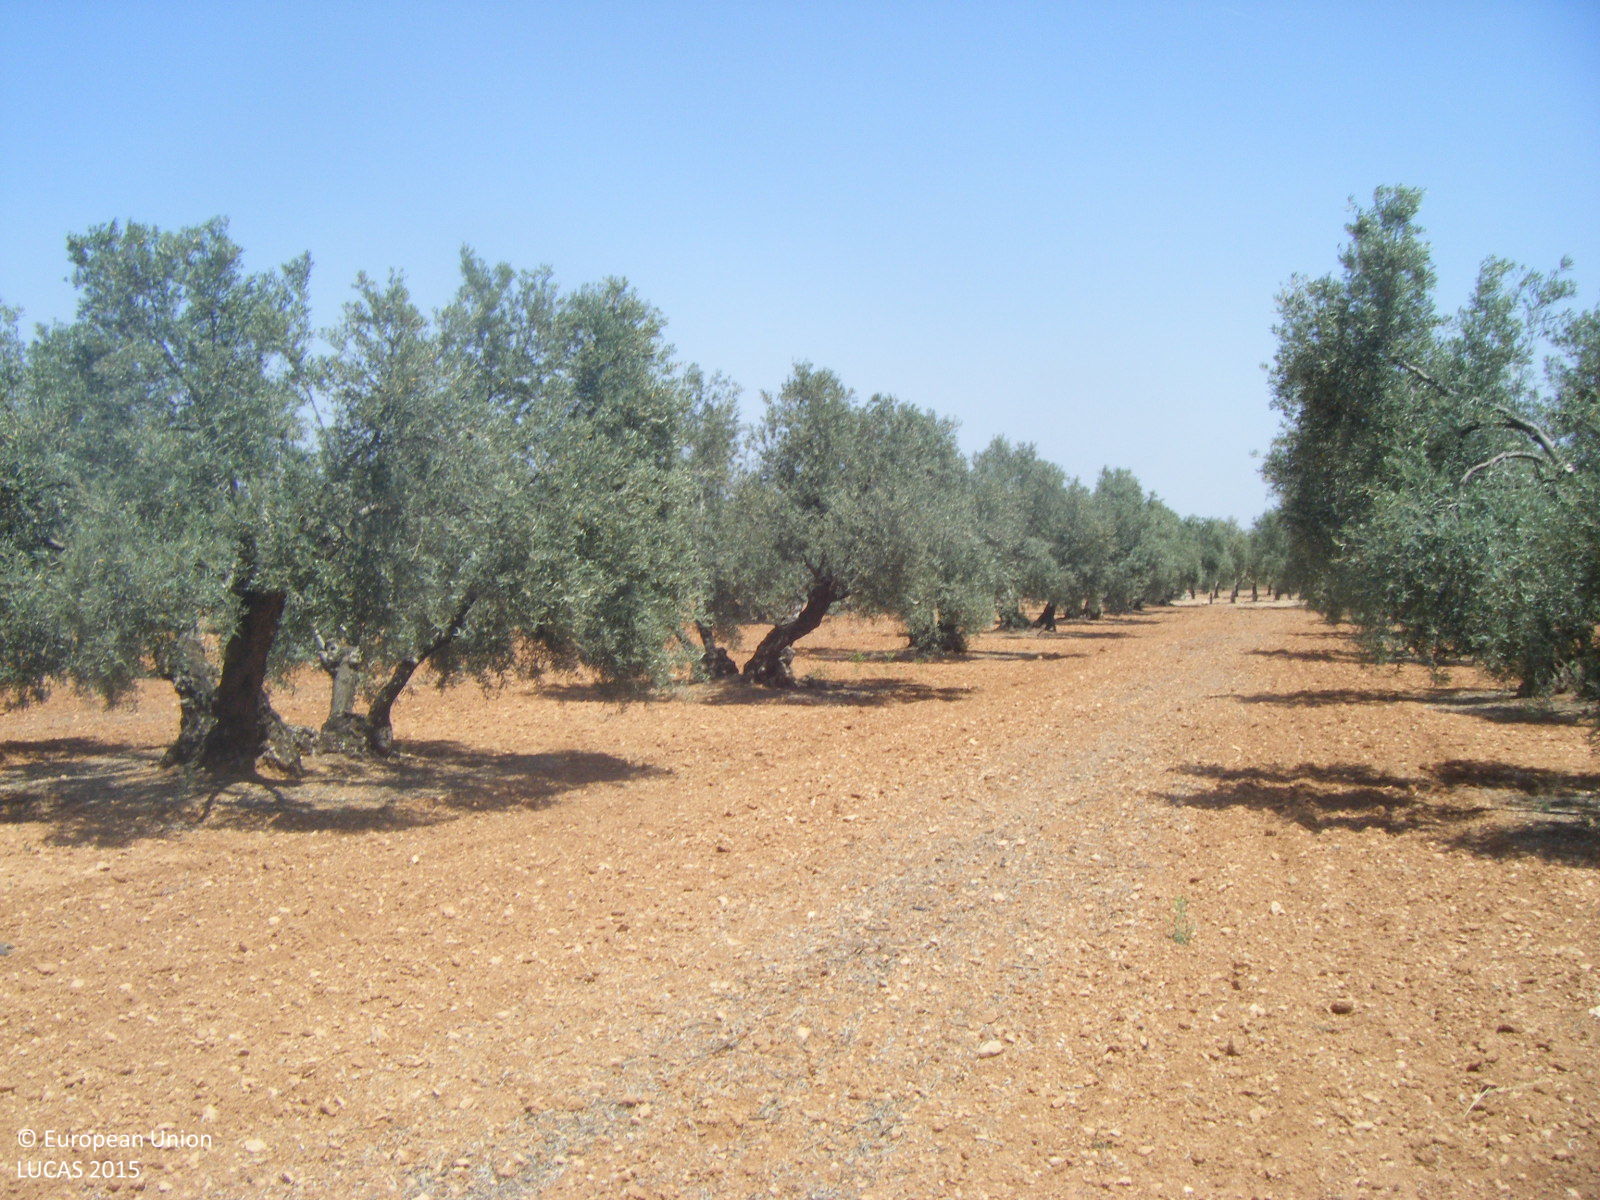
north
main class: Cropland
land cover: Olive groves
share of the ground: 25 - 50 %
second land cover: Other bare soil
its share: > 75 %
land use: Agriculture (excluding fallow land and kitchen gardens)
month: May
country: ES
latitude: 37.3187
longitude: -4.7986
